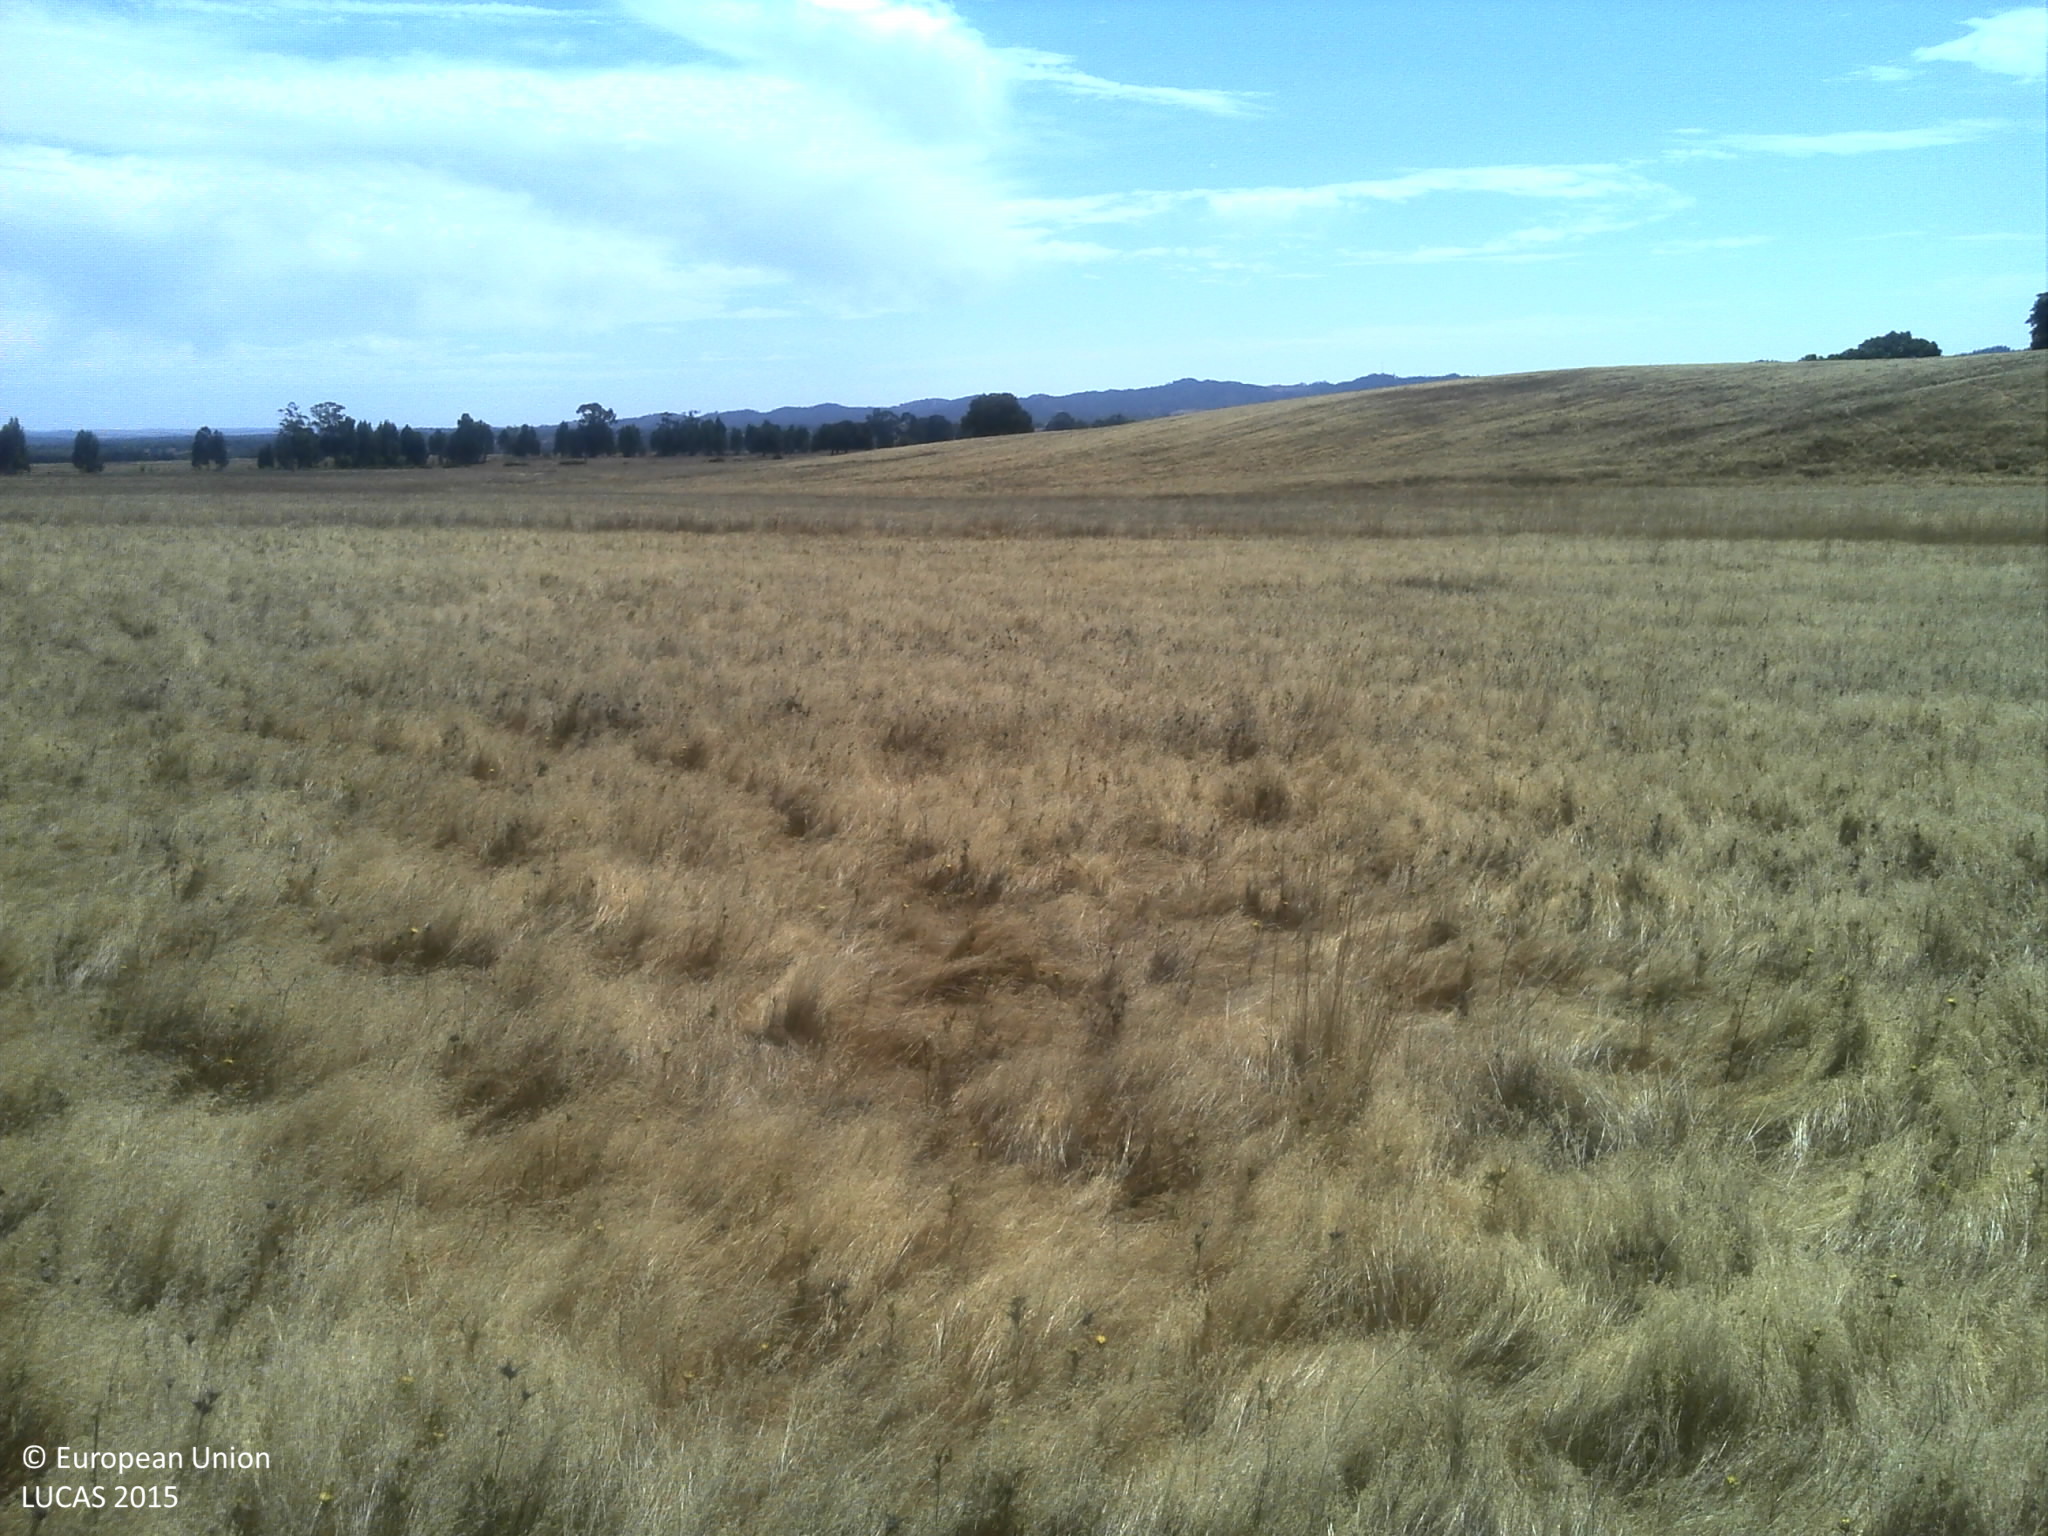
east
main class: Grassland
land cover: Grassland without tree/shrub cover
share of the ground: > 75 %
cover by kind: herbaceous plants 75 %, consolidated bare surface 25 %
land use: Agriculture (excluding fallow land and kitchen gardens)
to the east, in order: Grassland without tree/shrub cover; Ditches and canals; Grassland without tree/shrub cover
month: August
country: PT
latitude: 37.7493
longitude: -8.5033
